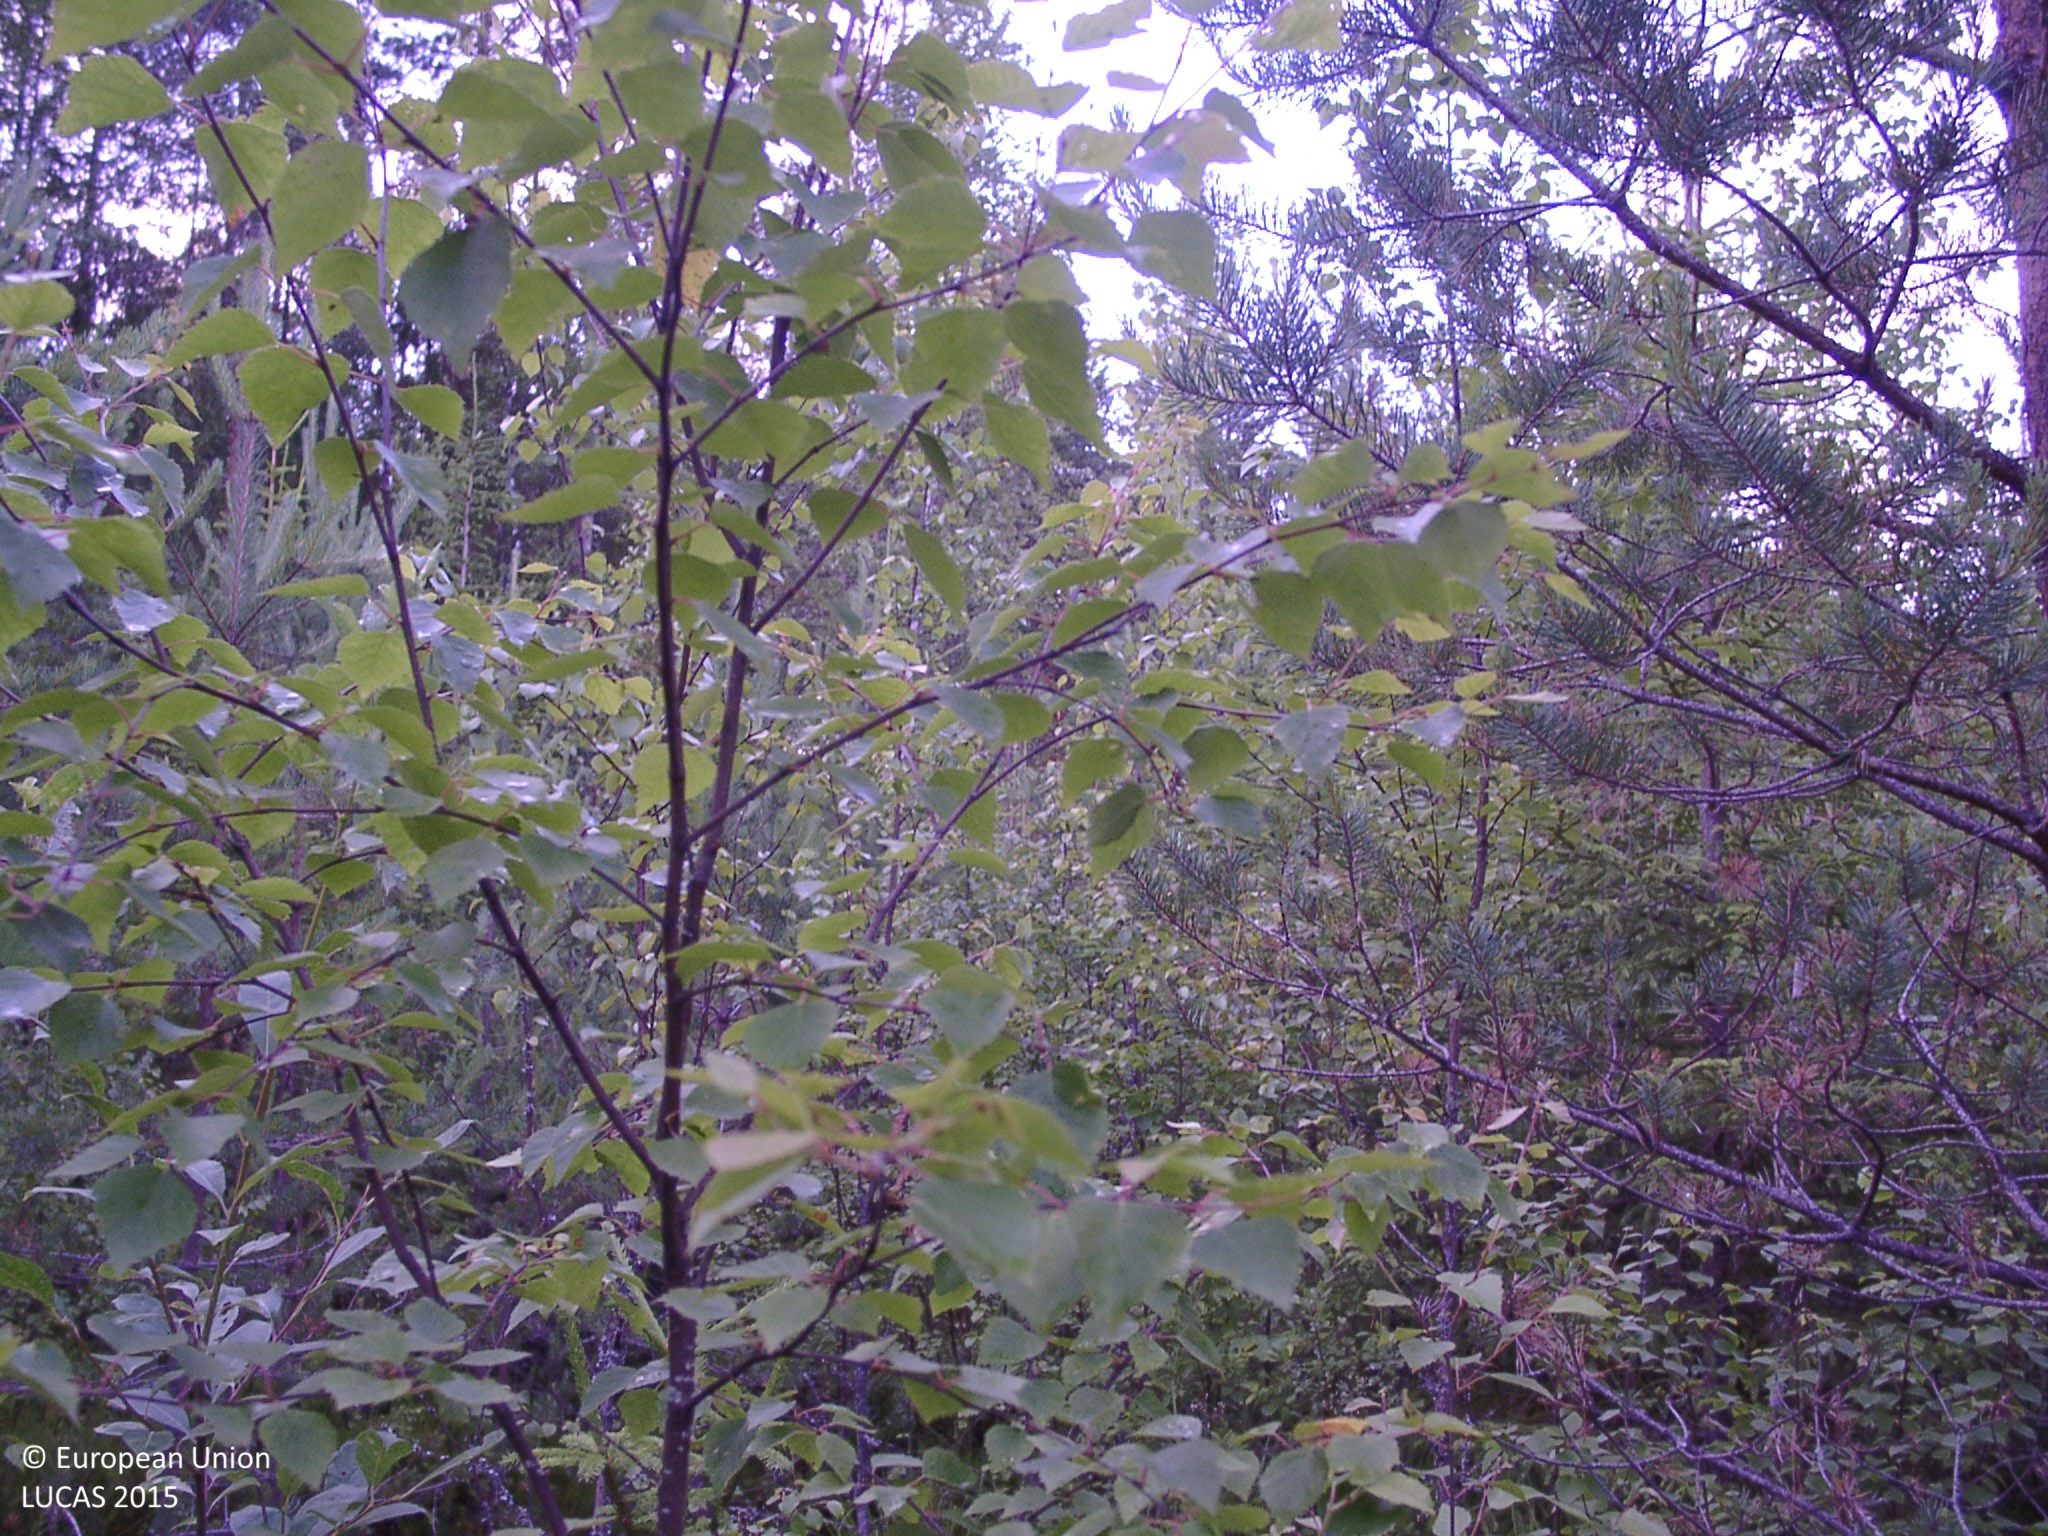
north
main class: Woodland
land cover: Other mixed woodland
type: boreal forest
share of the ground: 50 - 75 %
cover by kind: coniferous forest trees 50 %, broadleaved forest trees 20 %, shrubs 15 %, herbaceous plants 5 %, lichens and mosses 5 %
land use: Forestry
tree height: < 5 m
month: July
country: FI
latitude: 61.8399
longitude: 24.7842
